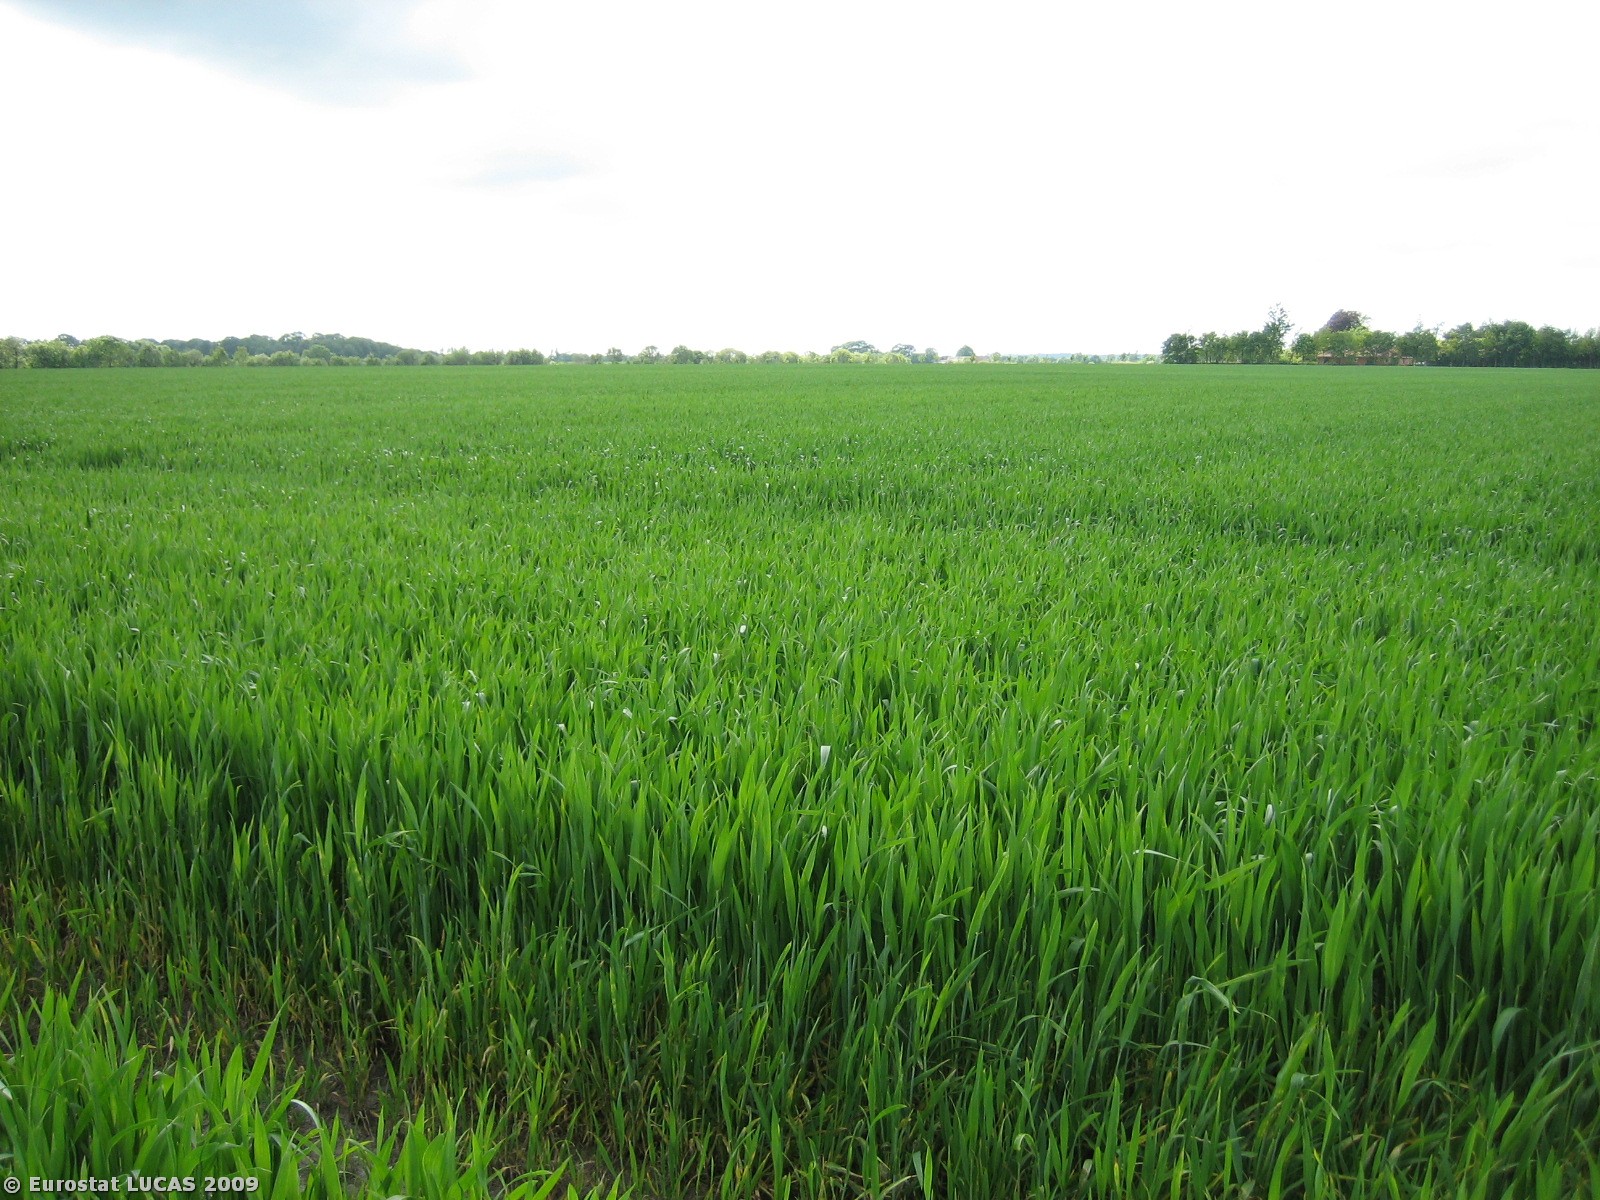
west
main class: Cropland
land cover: Barley
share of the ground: > 75 %
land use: Agriculture (excluding fallow land and kitchen gardens)
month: May
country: DK
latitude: 56.0212
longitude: 8.8942
